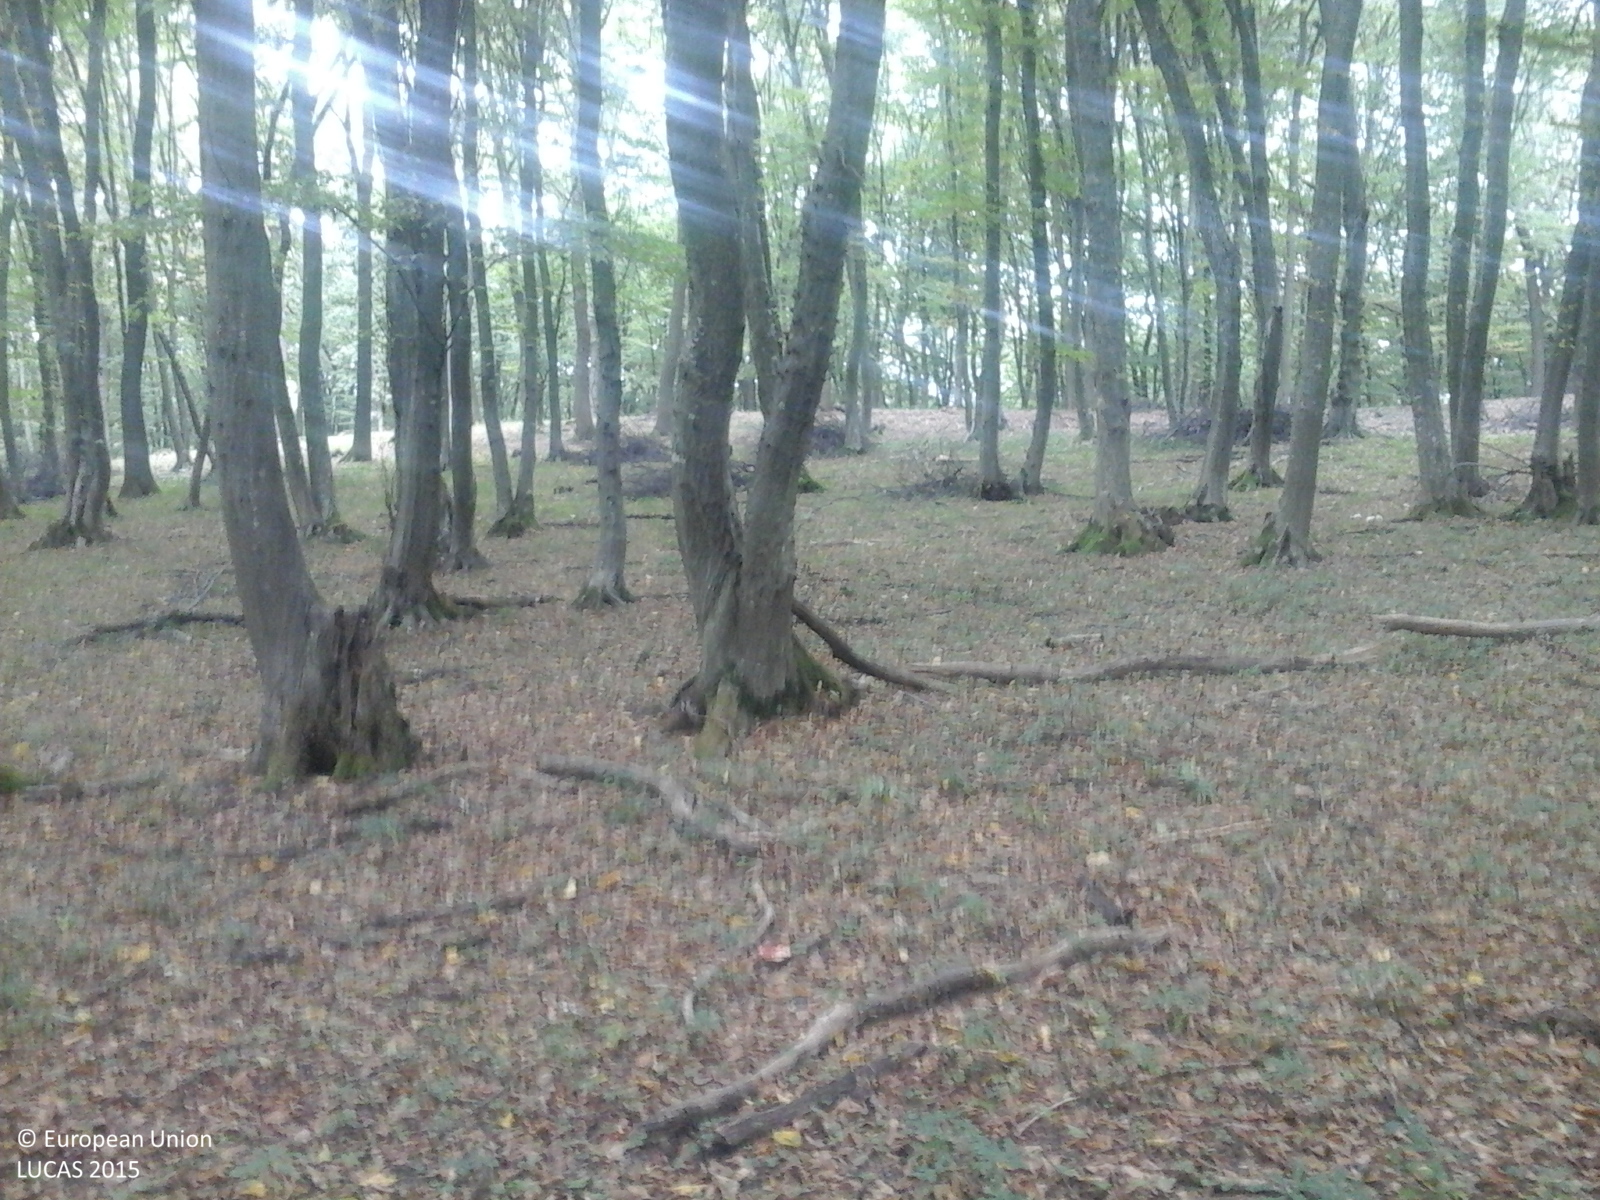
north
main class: Woodland
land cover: Broadleaved woodland
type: mesophytic deciduous forest
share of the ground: > 75 %
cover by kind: broadleaved forest trees 100 %
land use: Forestry
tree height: > 5 m
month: October
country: RO
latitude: 46.2568
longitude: 24.7360
